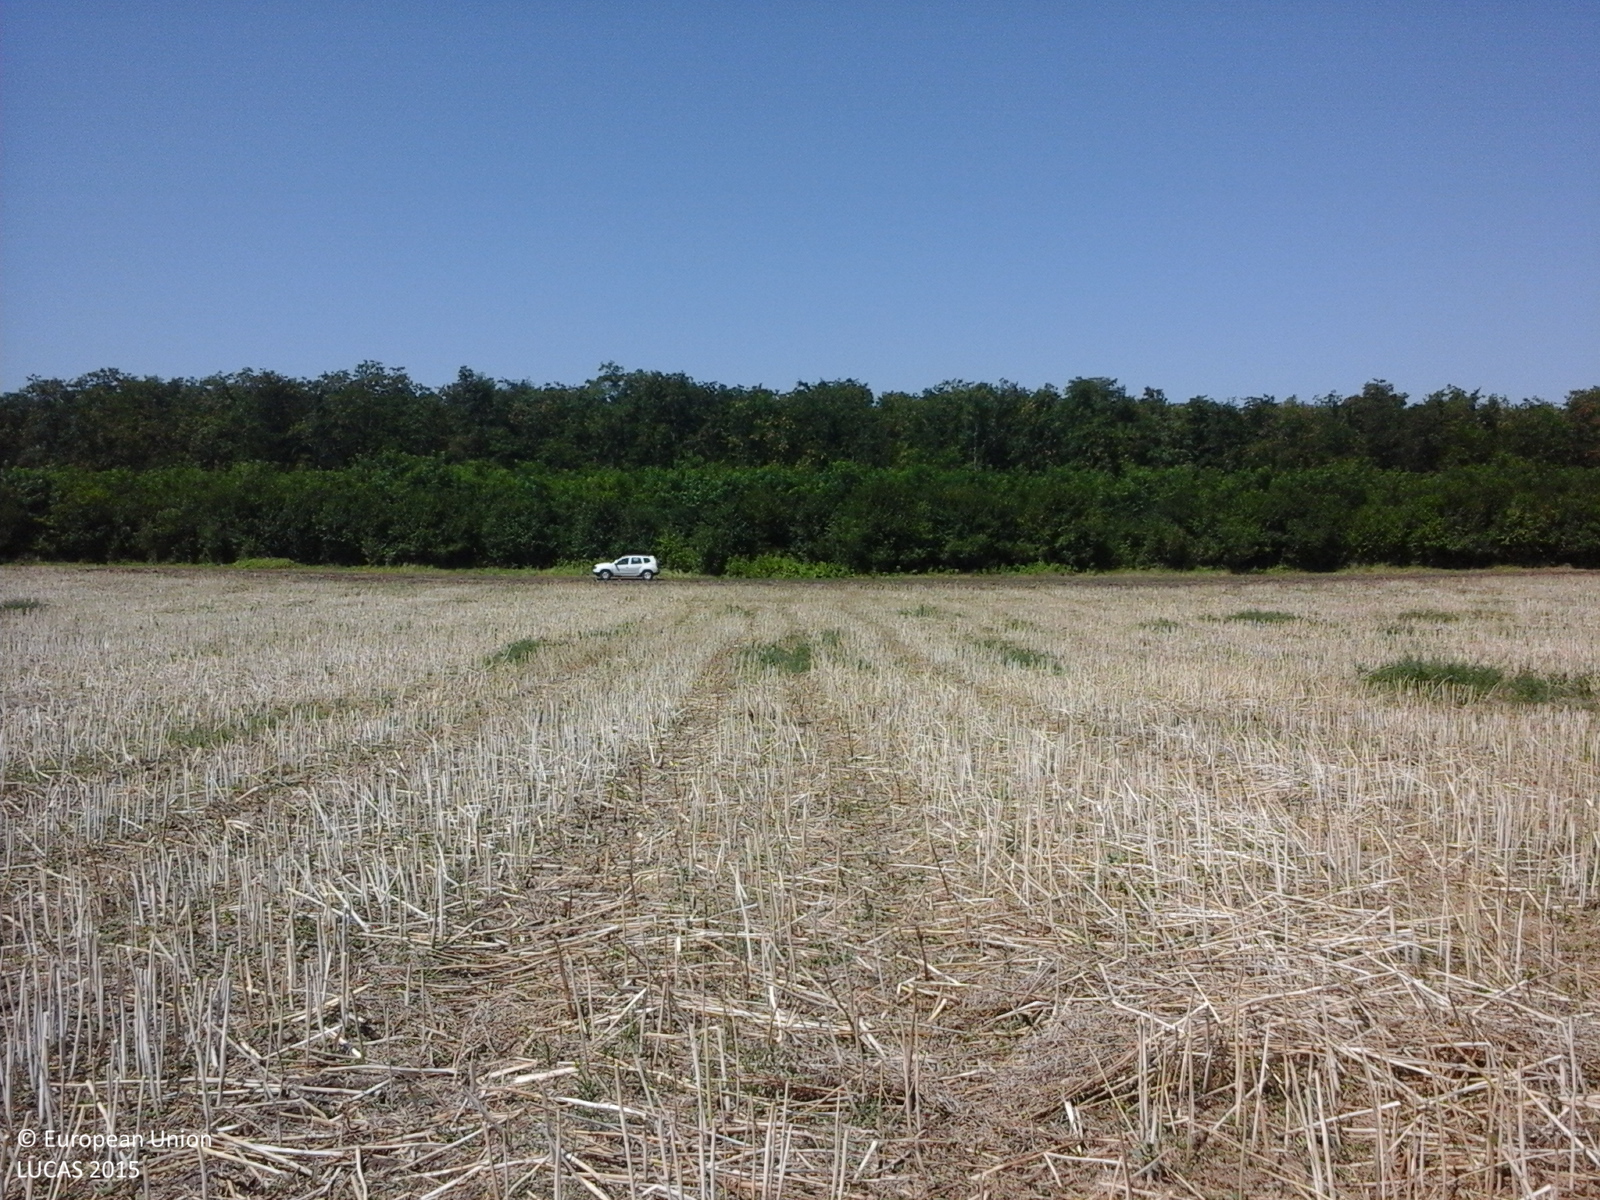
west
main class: Cropland
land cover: Rape and turnip rape
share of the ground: 10 - 25 %
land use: Agriculture (excluding fallow land and kitchen gardens)
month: July
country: RO
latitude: 44.3088
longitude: 26.7041
